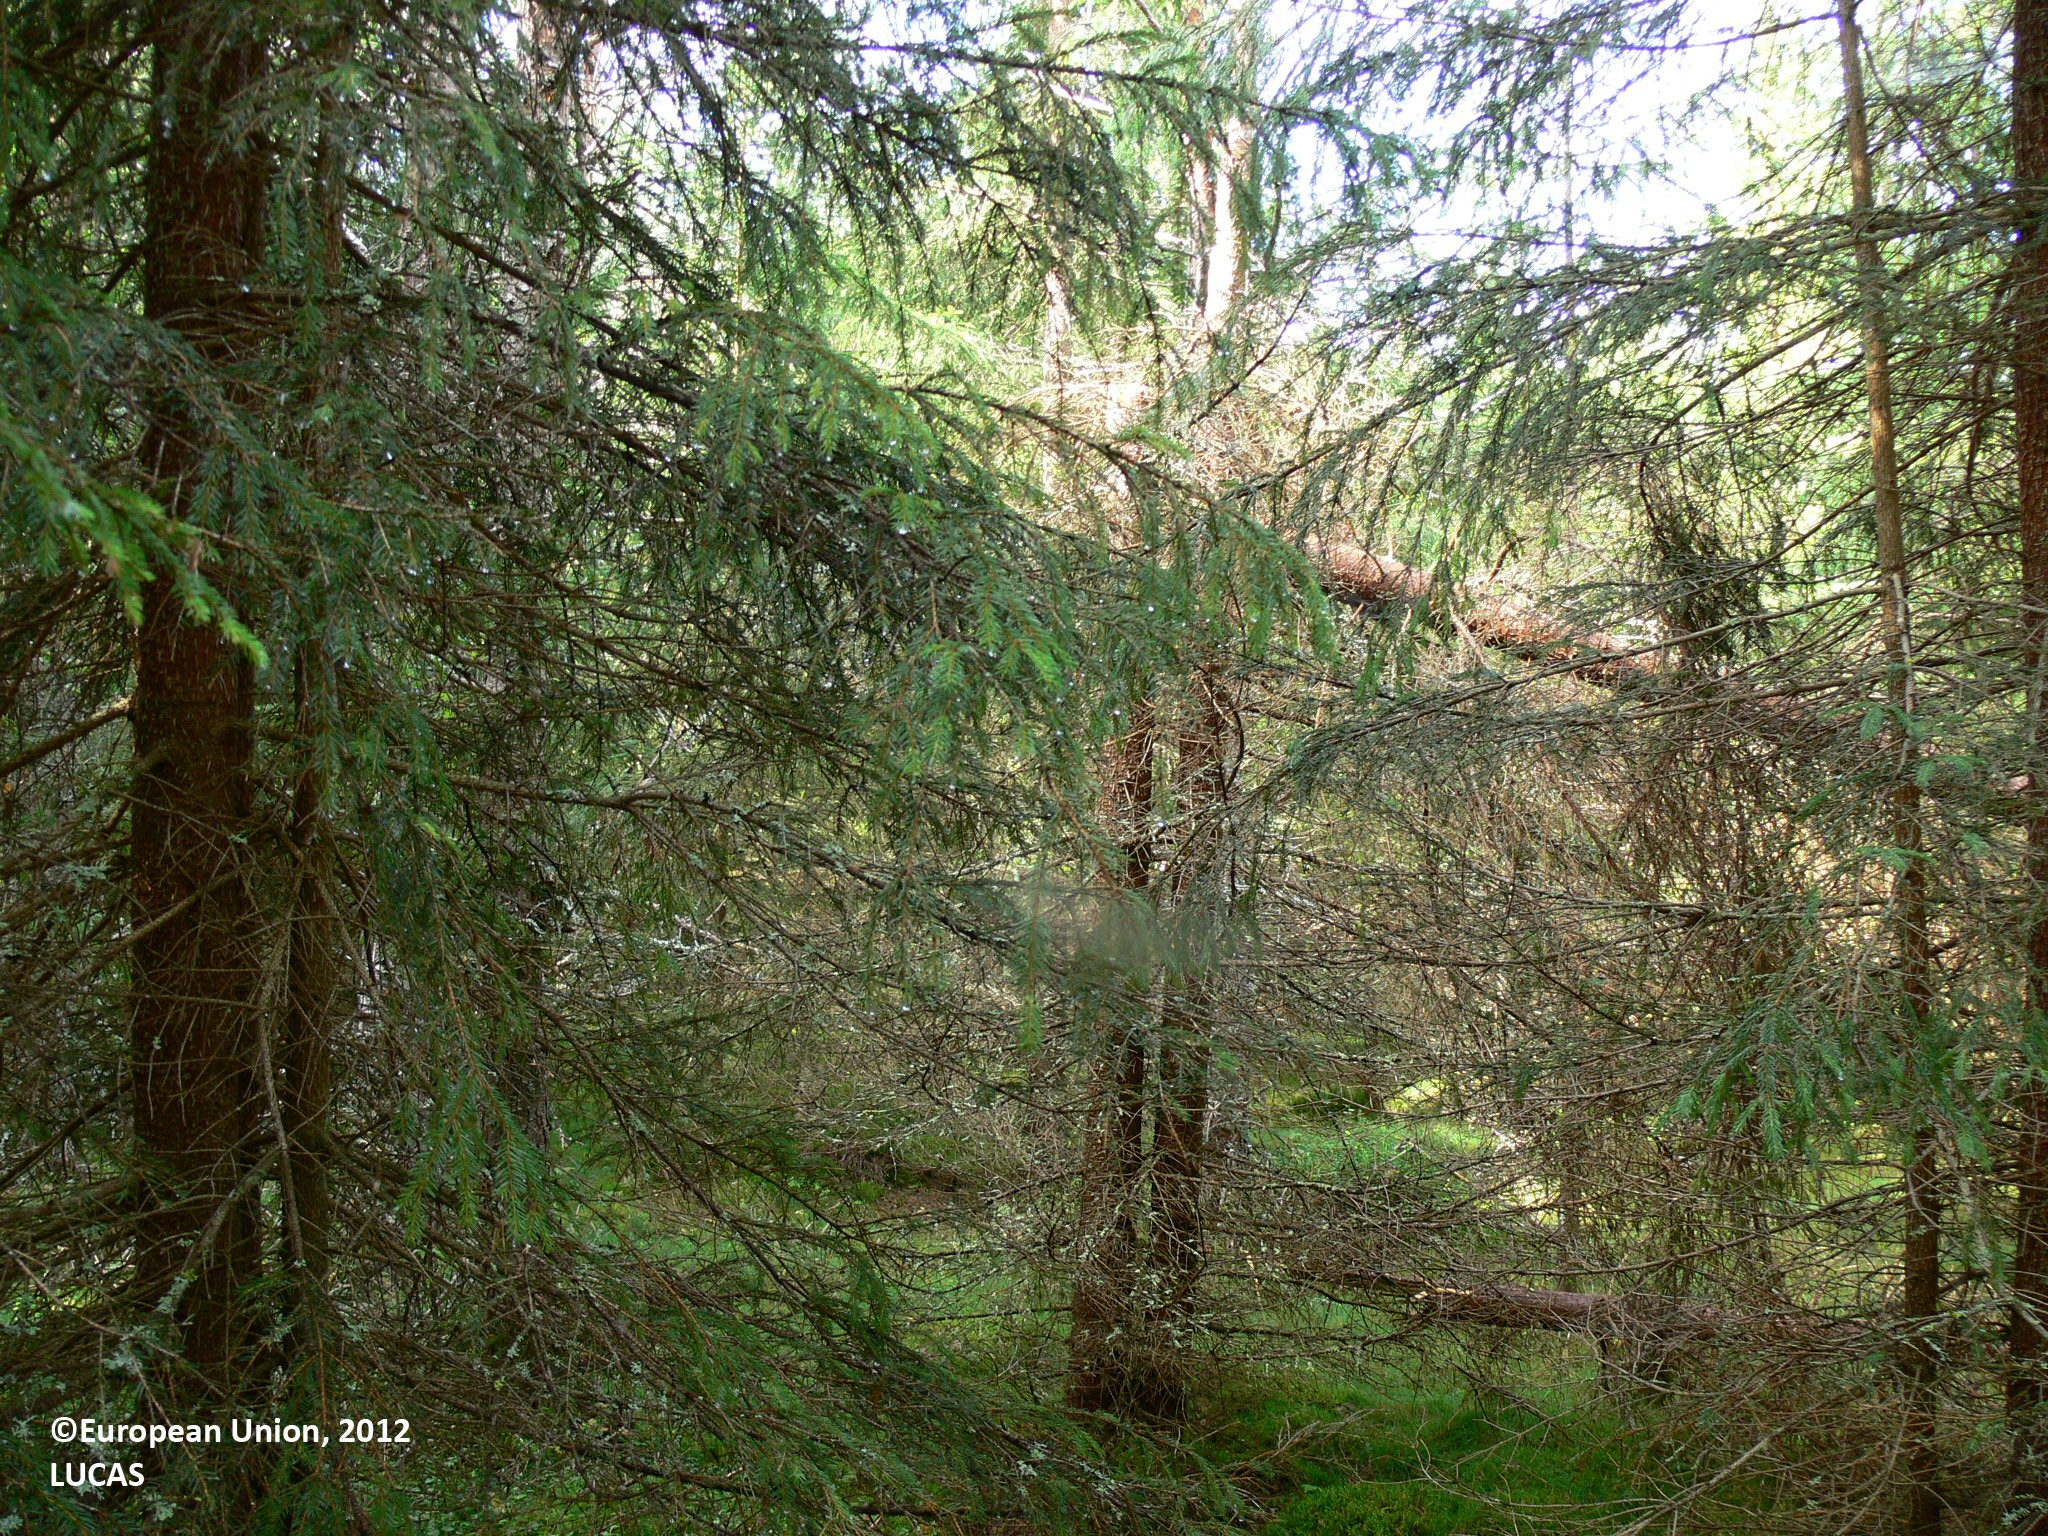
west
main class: Woodland
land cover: Other coniferous woodland
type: boreal forest
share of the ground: > 75 %
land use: Forestry
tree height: > 5 m
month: August
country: FI
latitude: 61.7170
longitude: 29.8434
